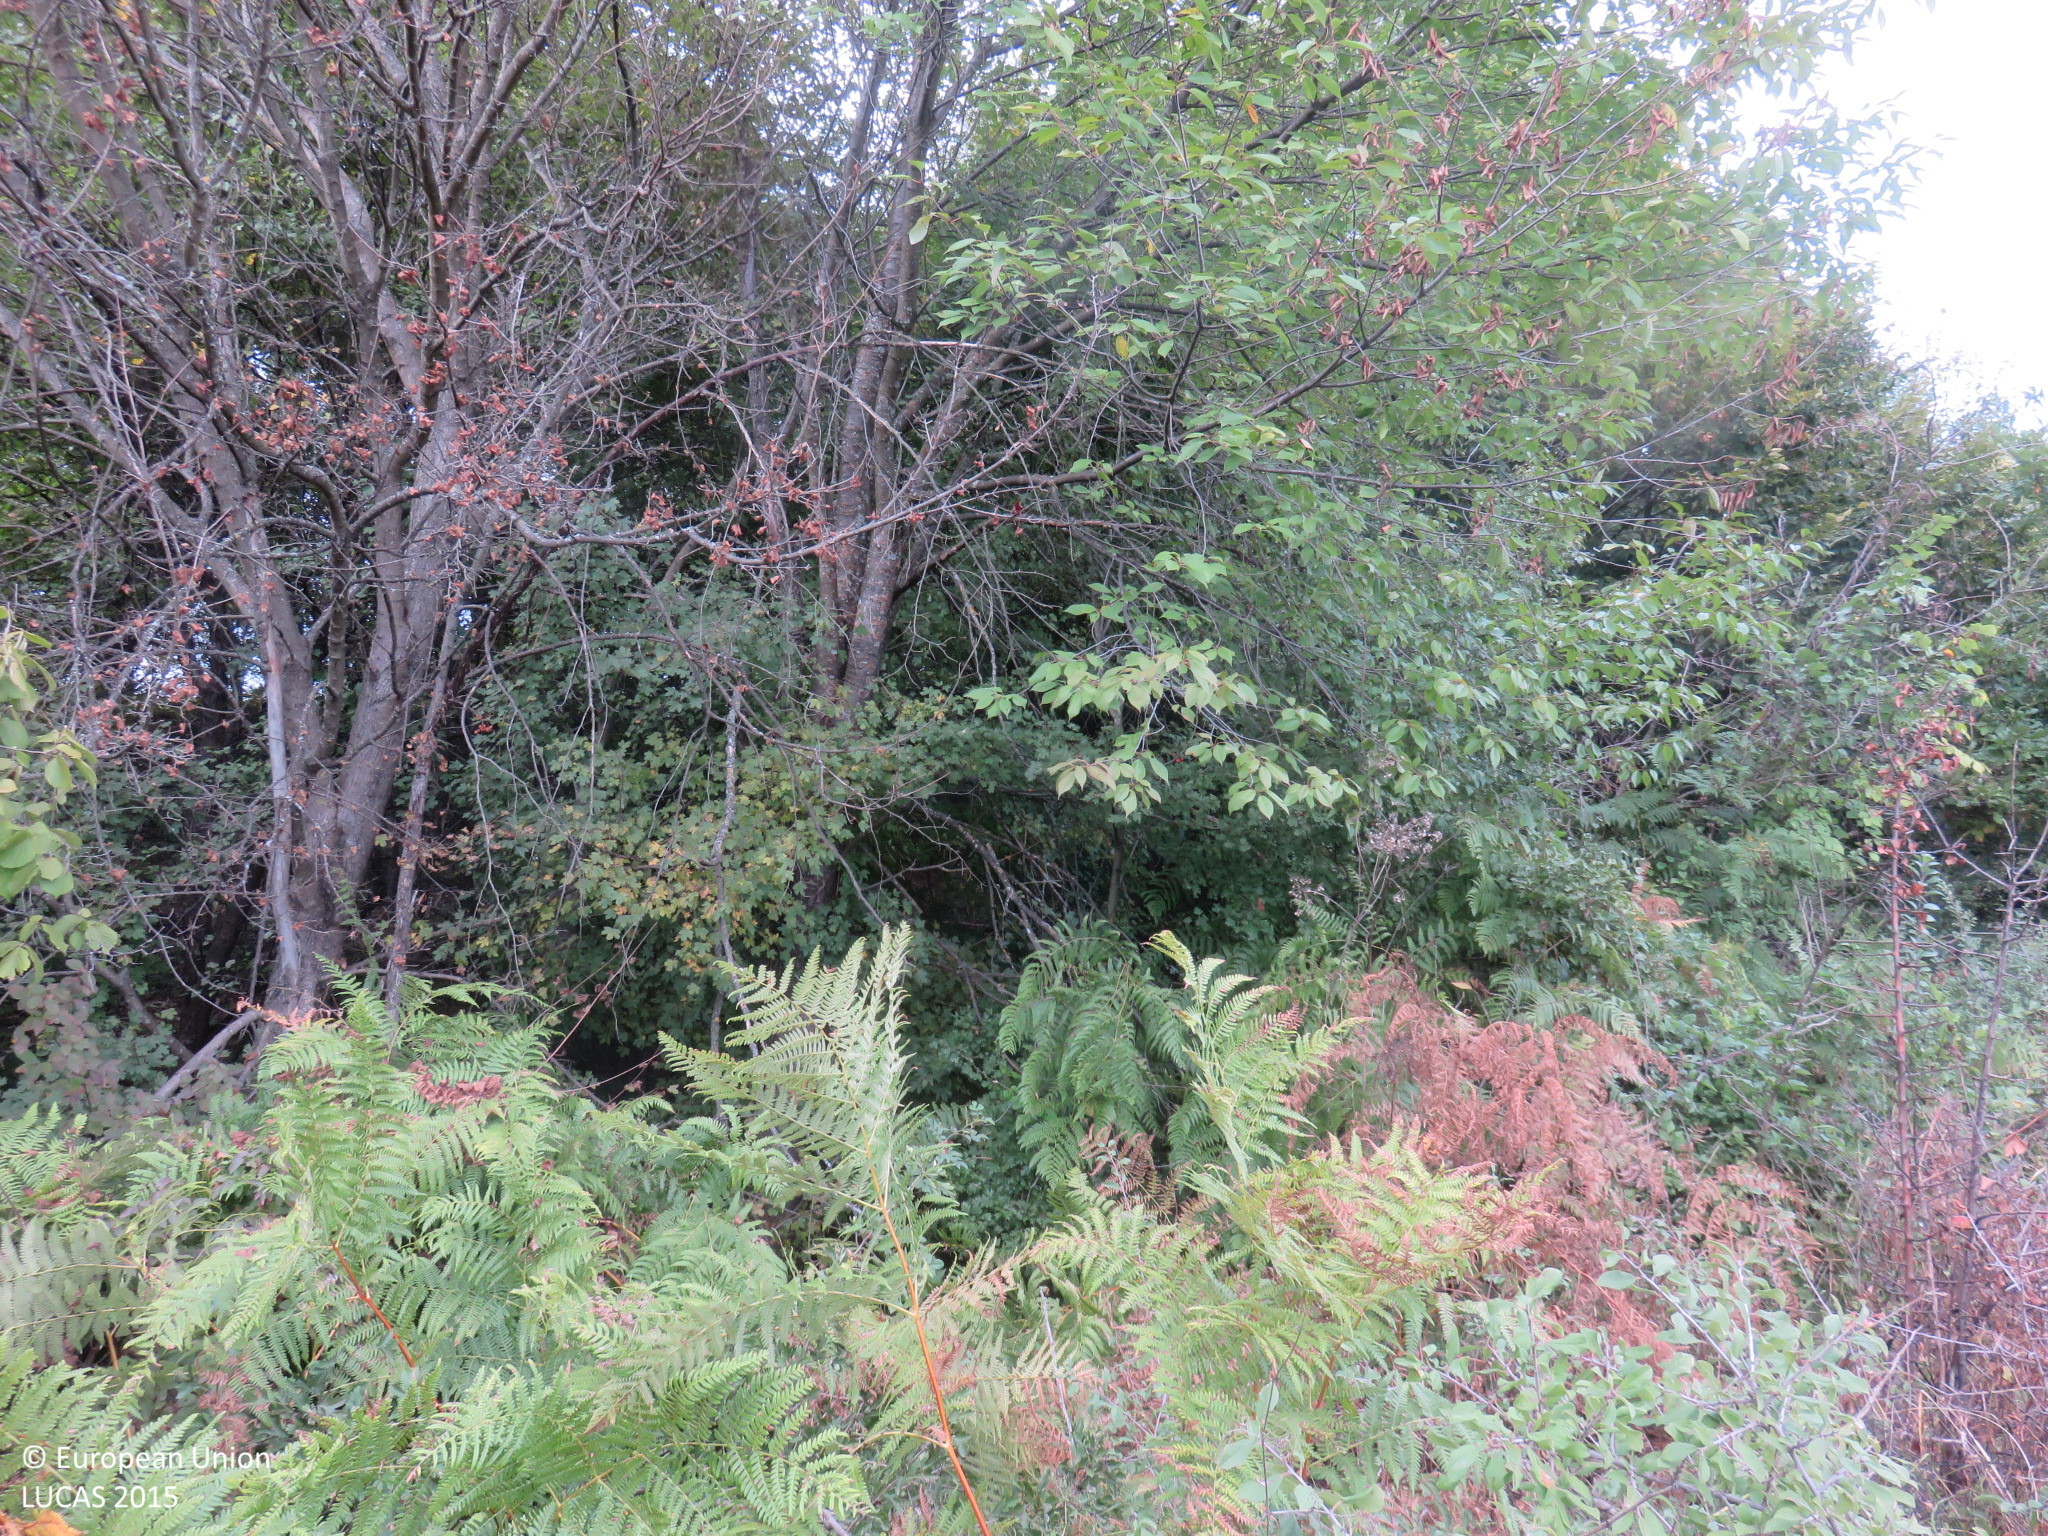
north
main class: Shrubland
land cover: Shrubland with sparse tree cover
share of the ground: > 75 %
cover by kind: shrubs 90 %, broadleaved forest trees 5 %, herbaceous plants 5 %
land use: Semi-natural and natural areas not in use
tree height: < 5 m
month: October
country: BG
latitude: 43.0540
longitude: 24.8581
